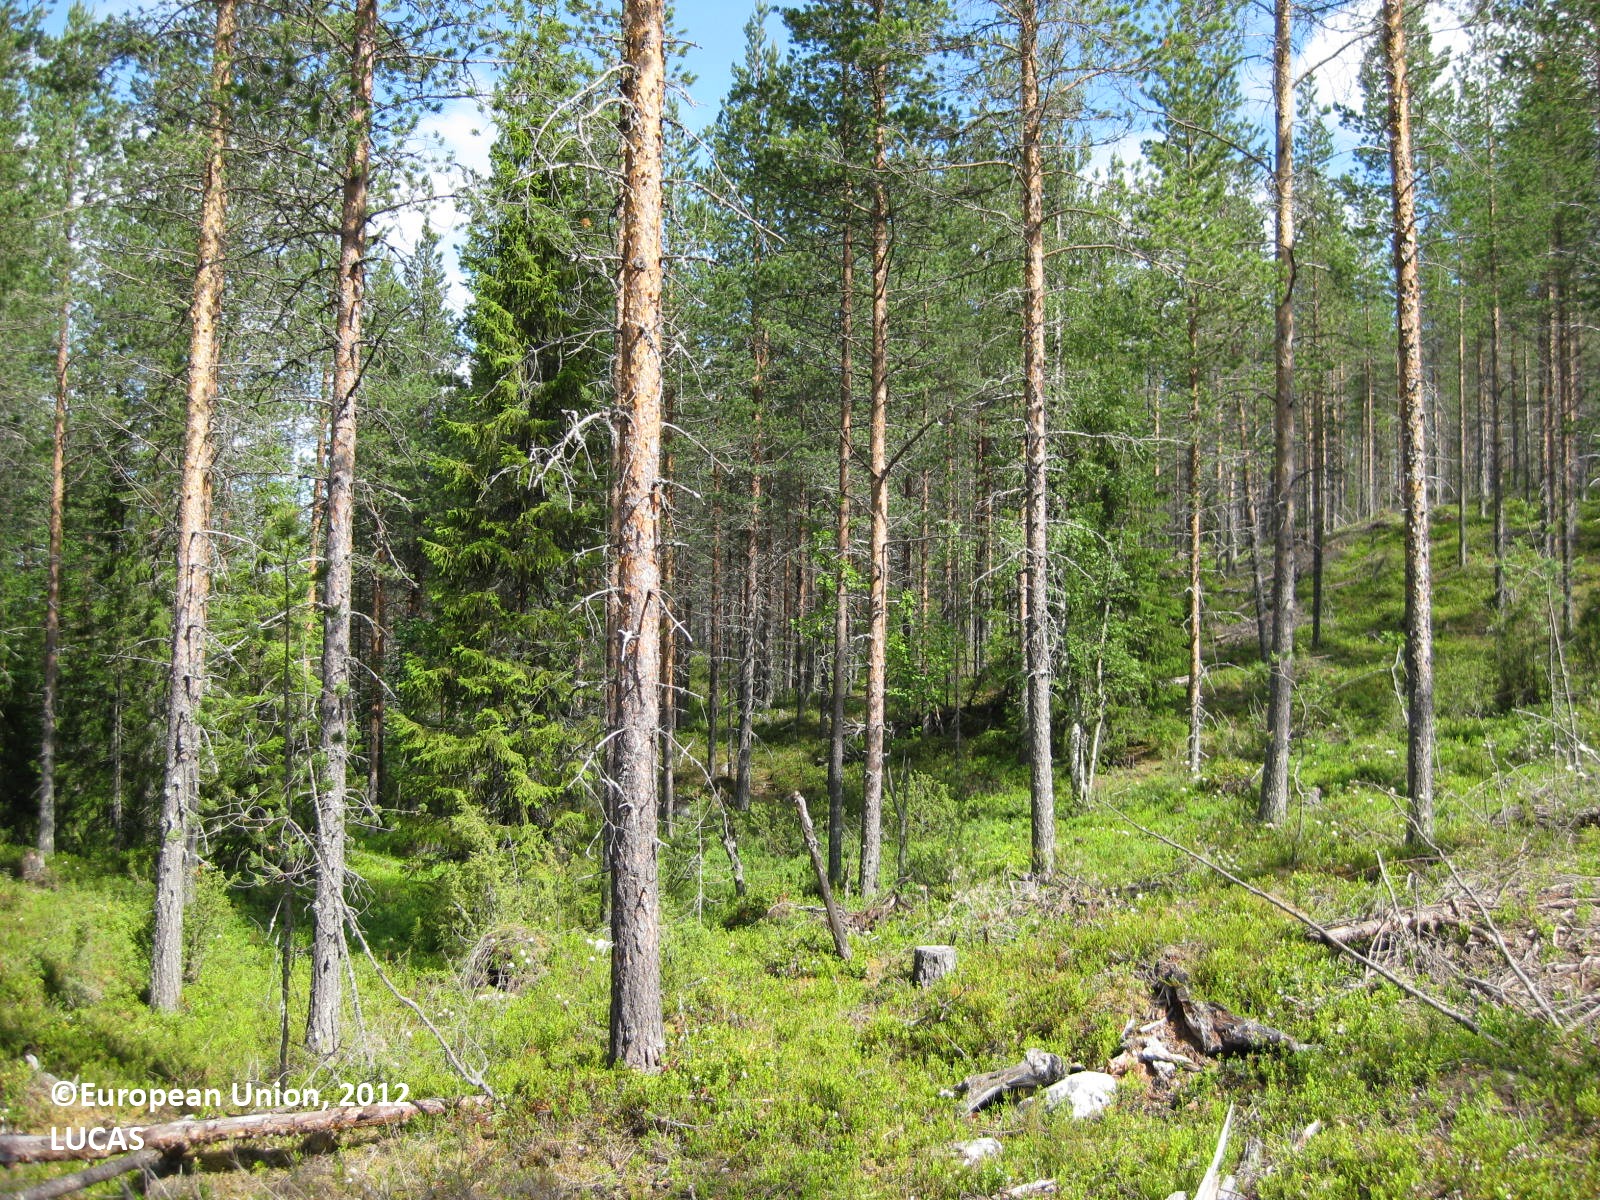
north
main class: Woodland
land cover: Pine dominated coniferous woodland
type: boreal forest
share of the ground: 25 - 50 %
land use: Forestry
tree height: > 5 m
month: July
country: FI
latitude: 65.4557
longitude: 29.5087
